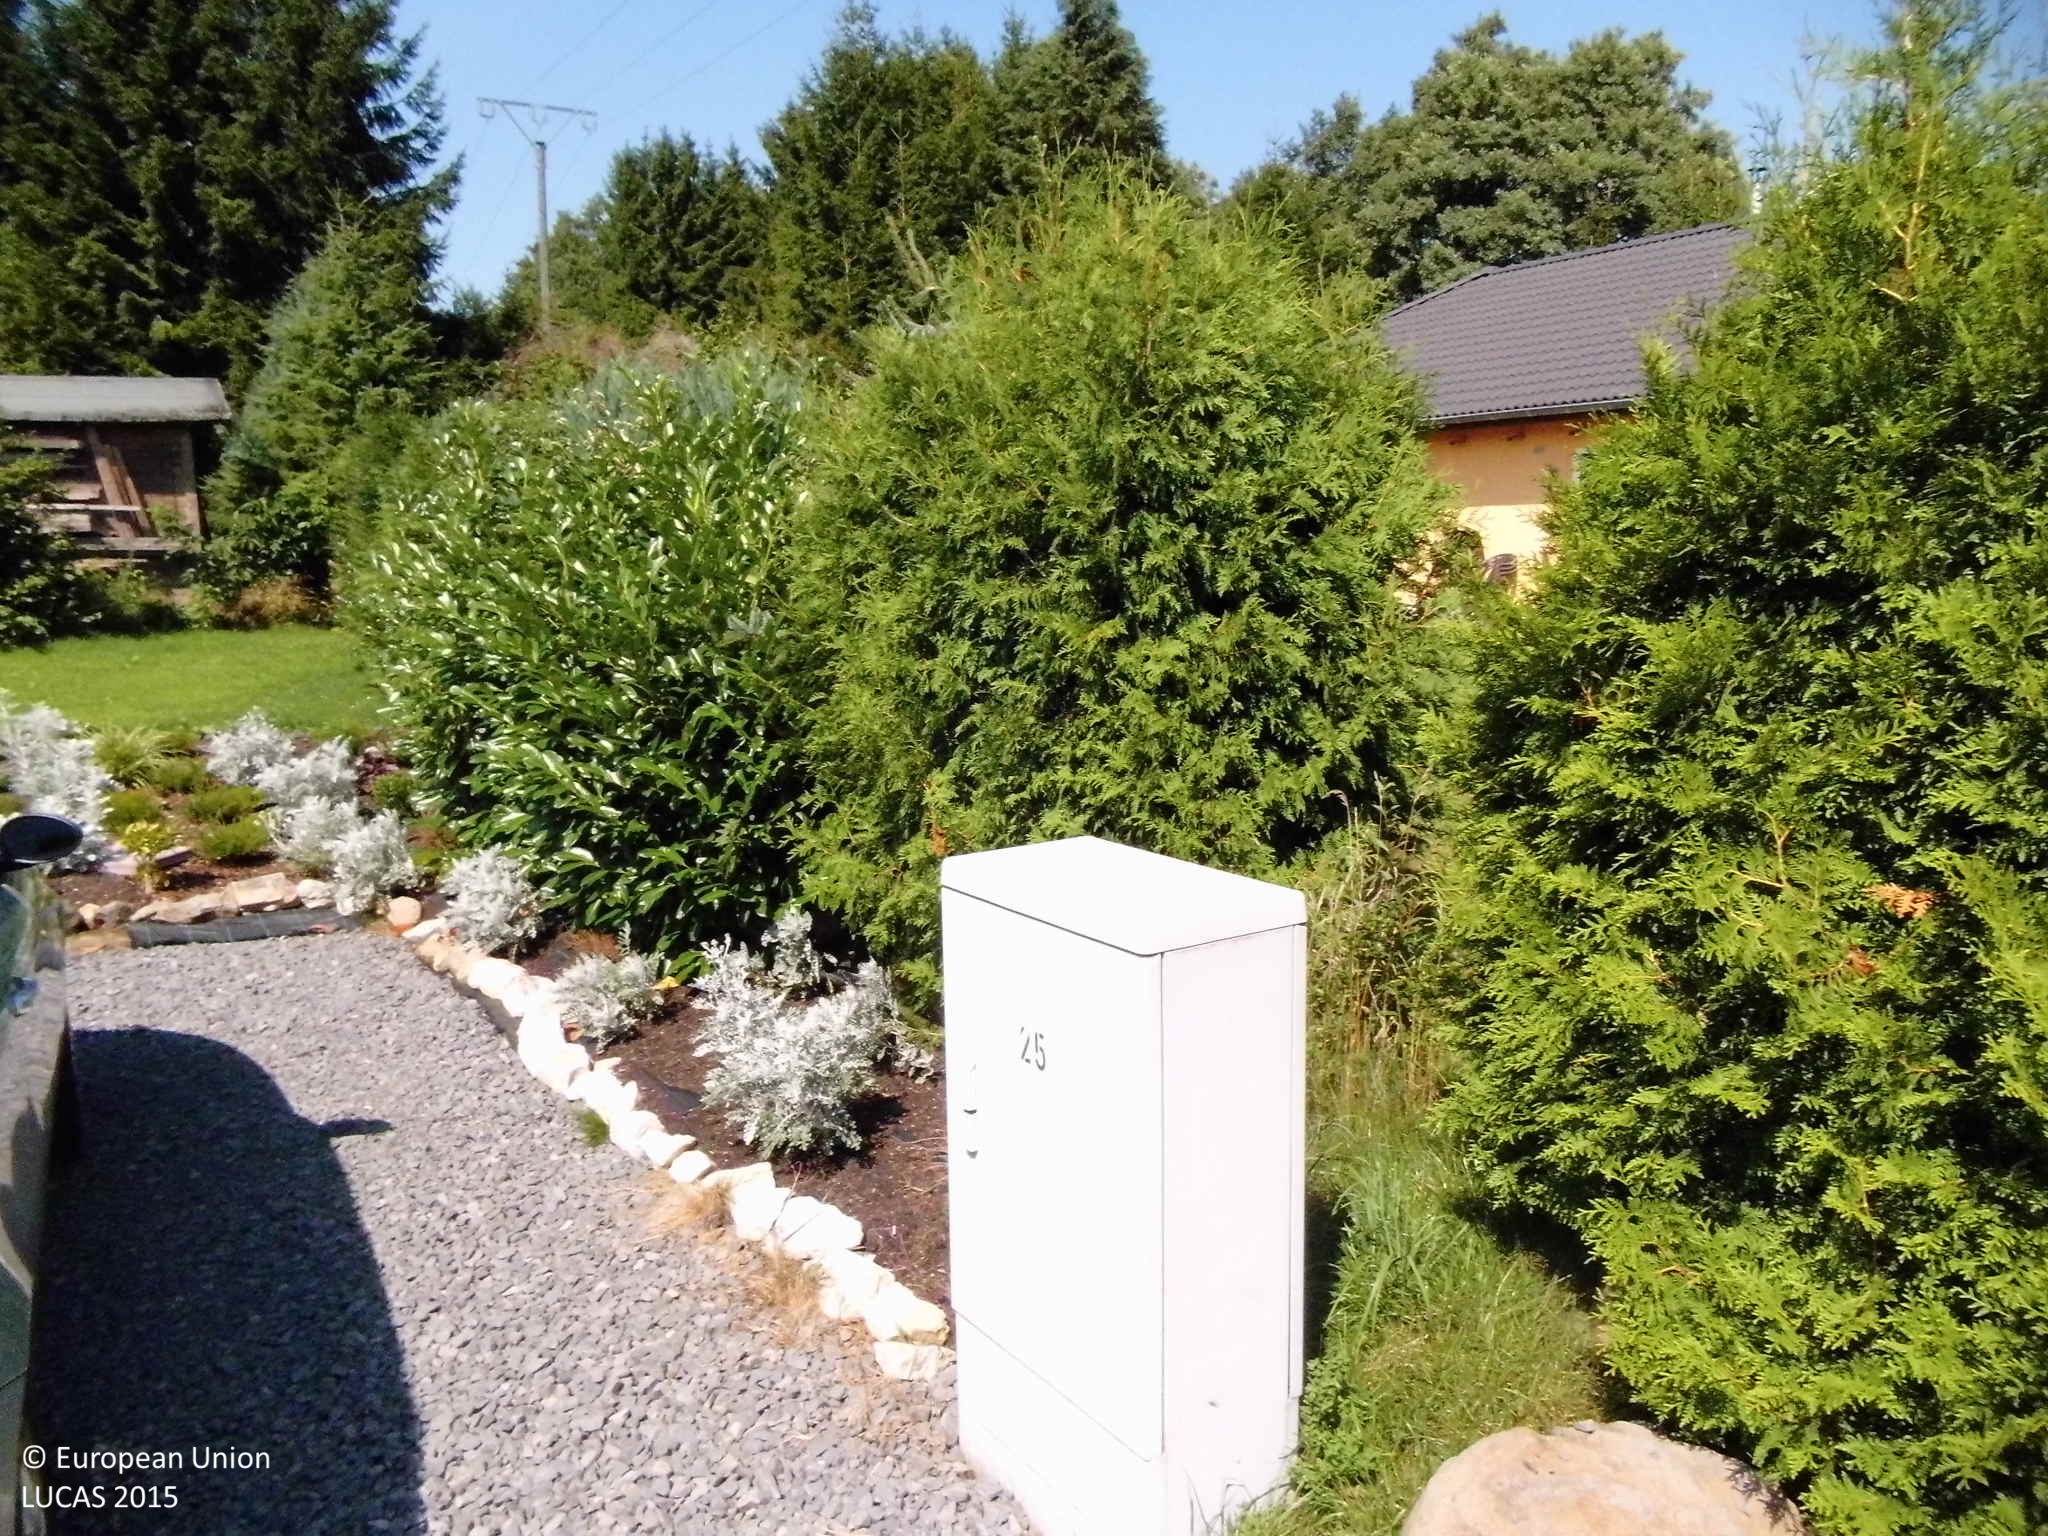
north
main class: Cropland
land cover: Floriculture and ornamental plants
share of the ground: > 75 %
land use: Residential
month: August
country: DE
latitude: 50.6364
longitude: 8.1199
